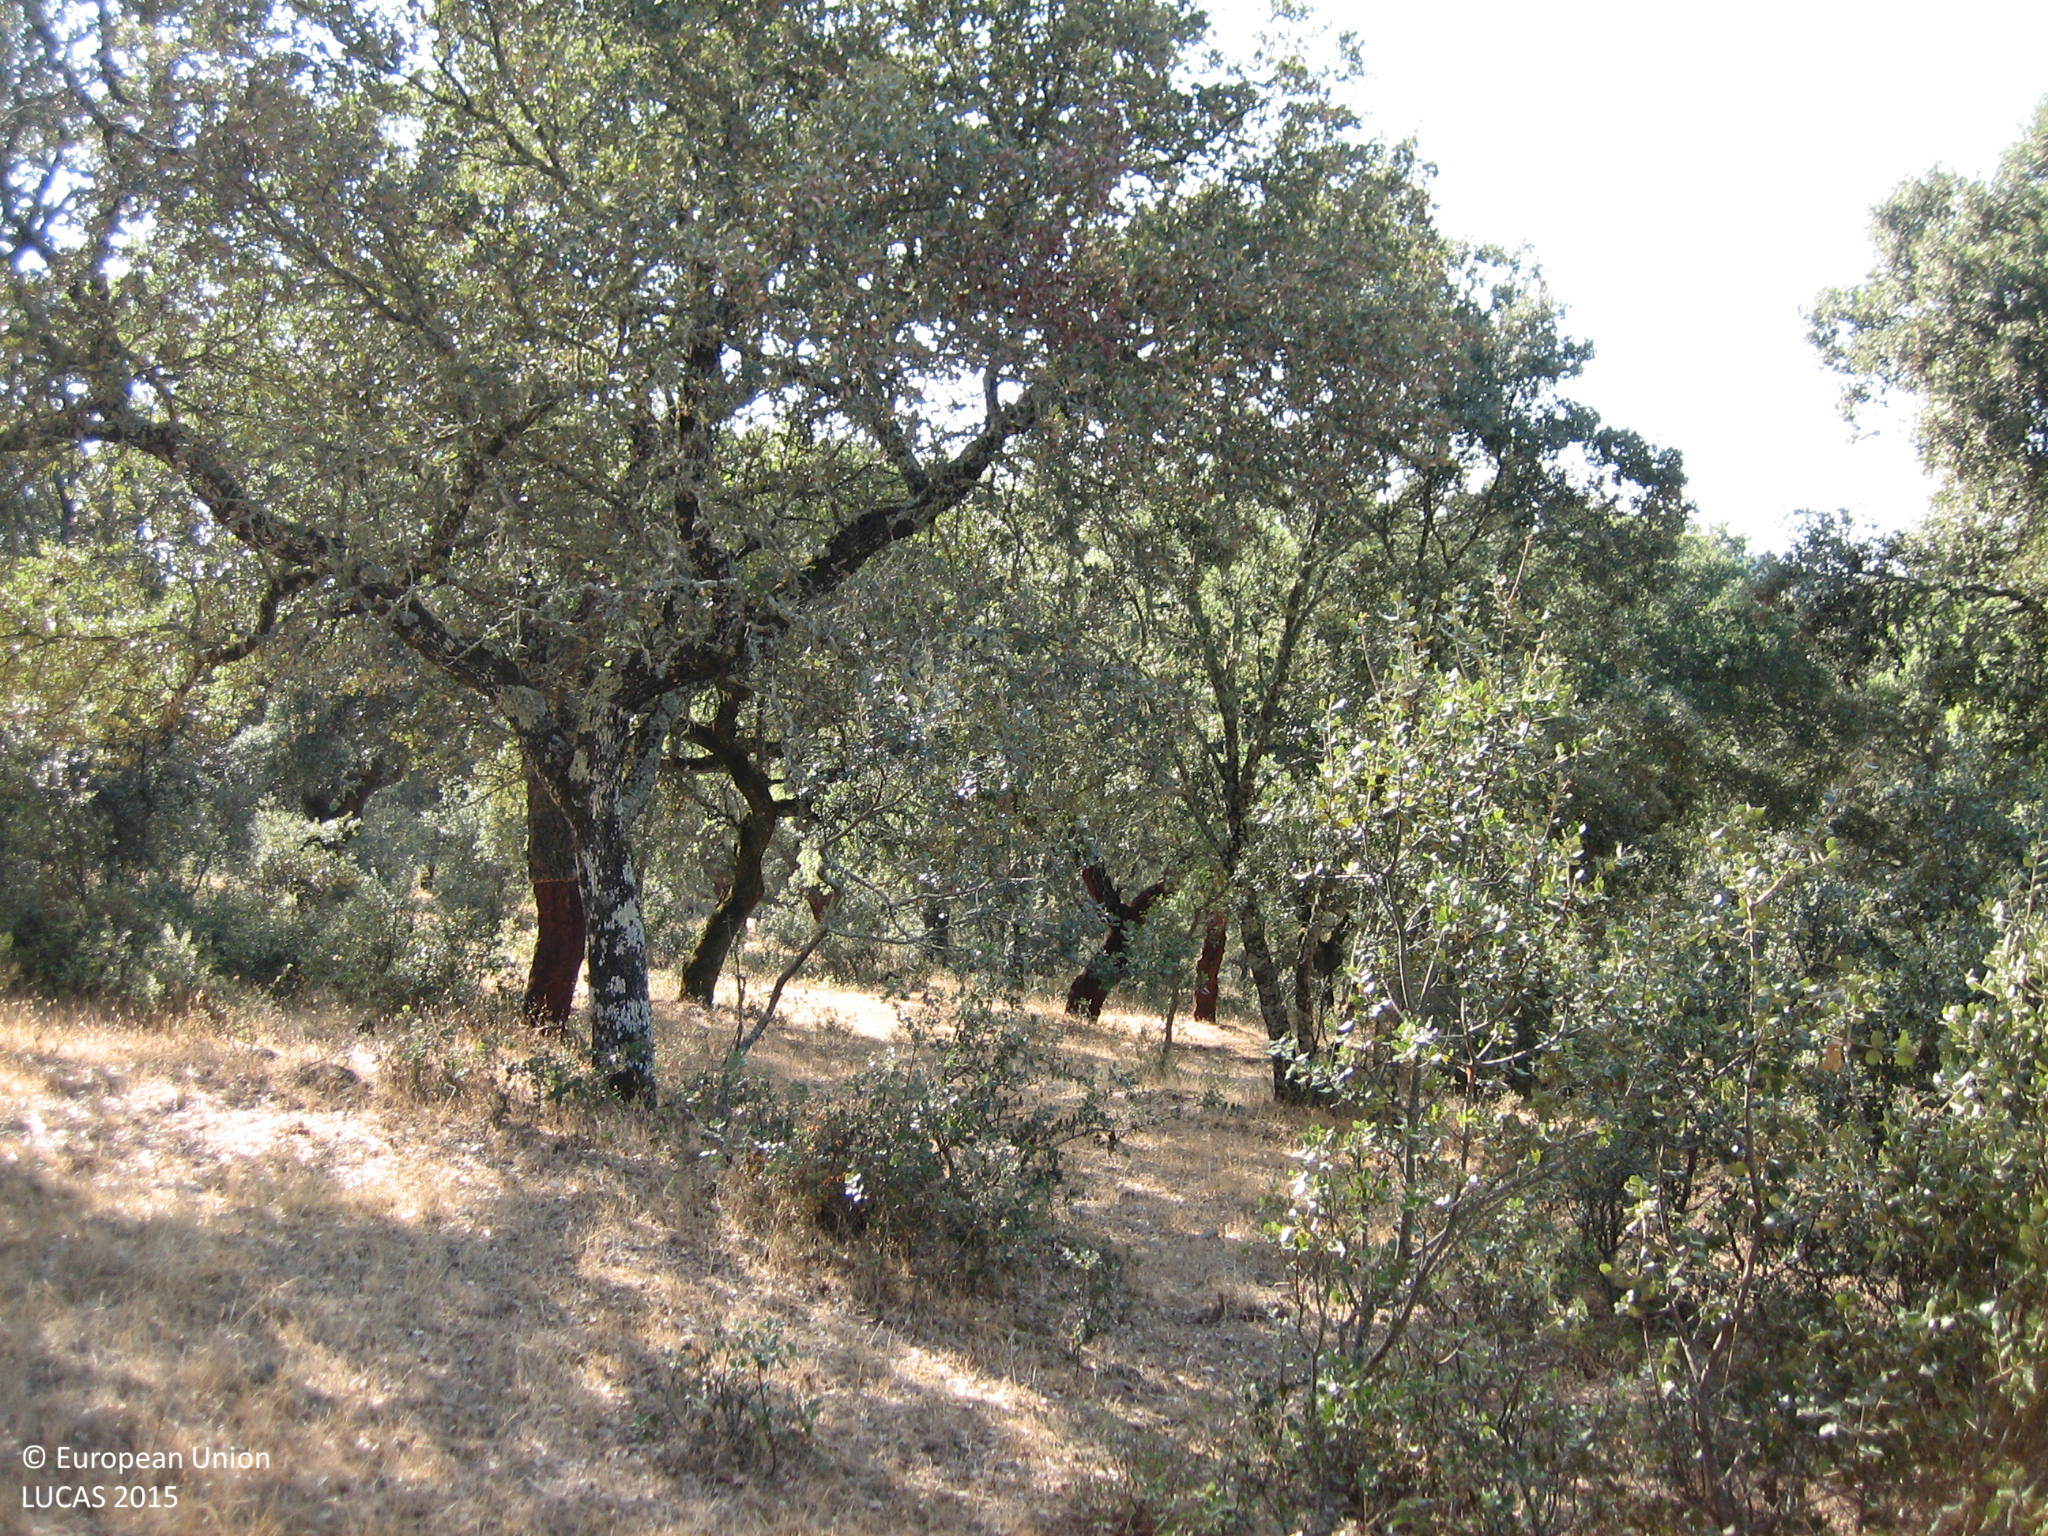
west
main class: Woodland
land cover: Broadleaved woodland
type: broadleaved evergreen forest
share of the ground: > 75 %
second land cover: Shrubland without tree cover
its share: 10 - 25 %
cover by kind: broadleaved forest trees 75 %, herbaceous plants 15 %, shrubs 10 %
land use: Forestry
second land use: Agriculture (excluding fallow land and kitchen gardens)
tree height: > 5 m
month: September
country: ES
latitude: 38.4405
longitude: -6.8903
